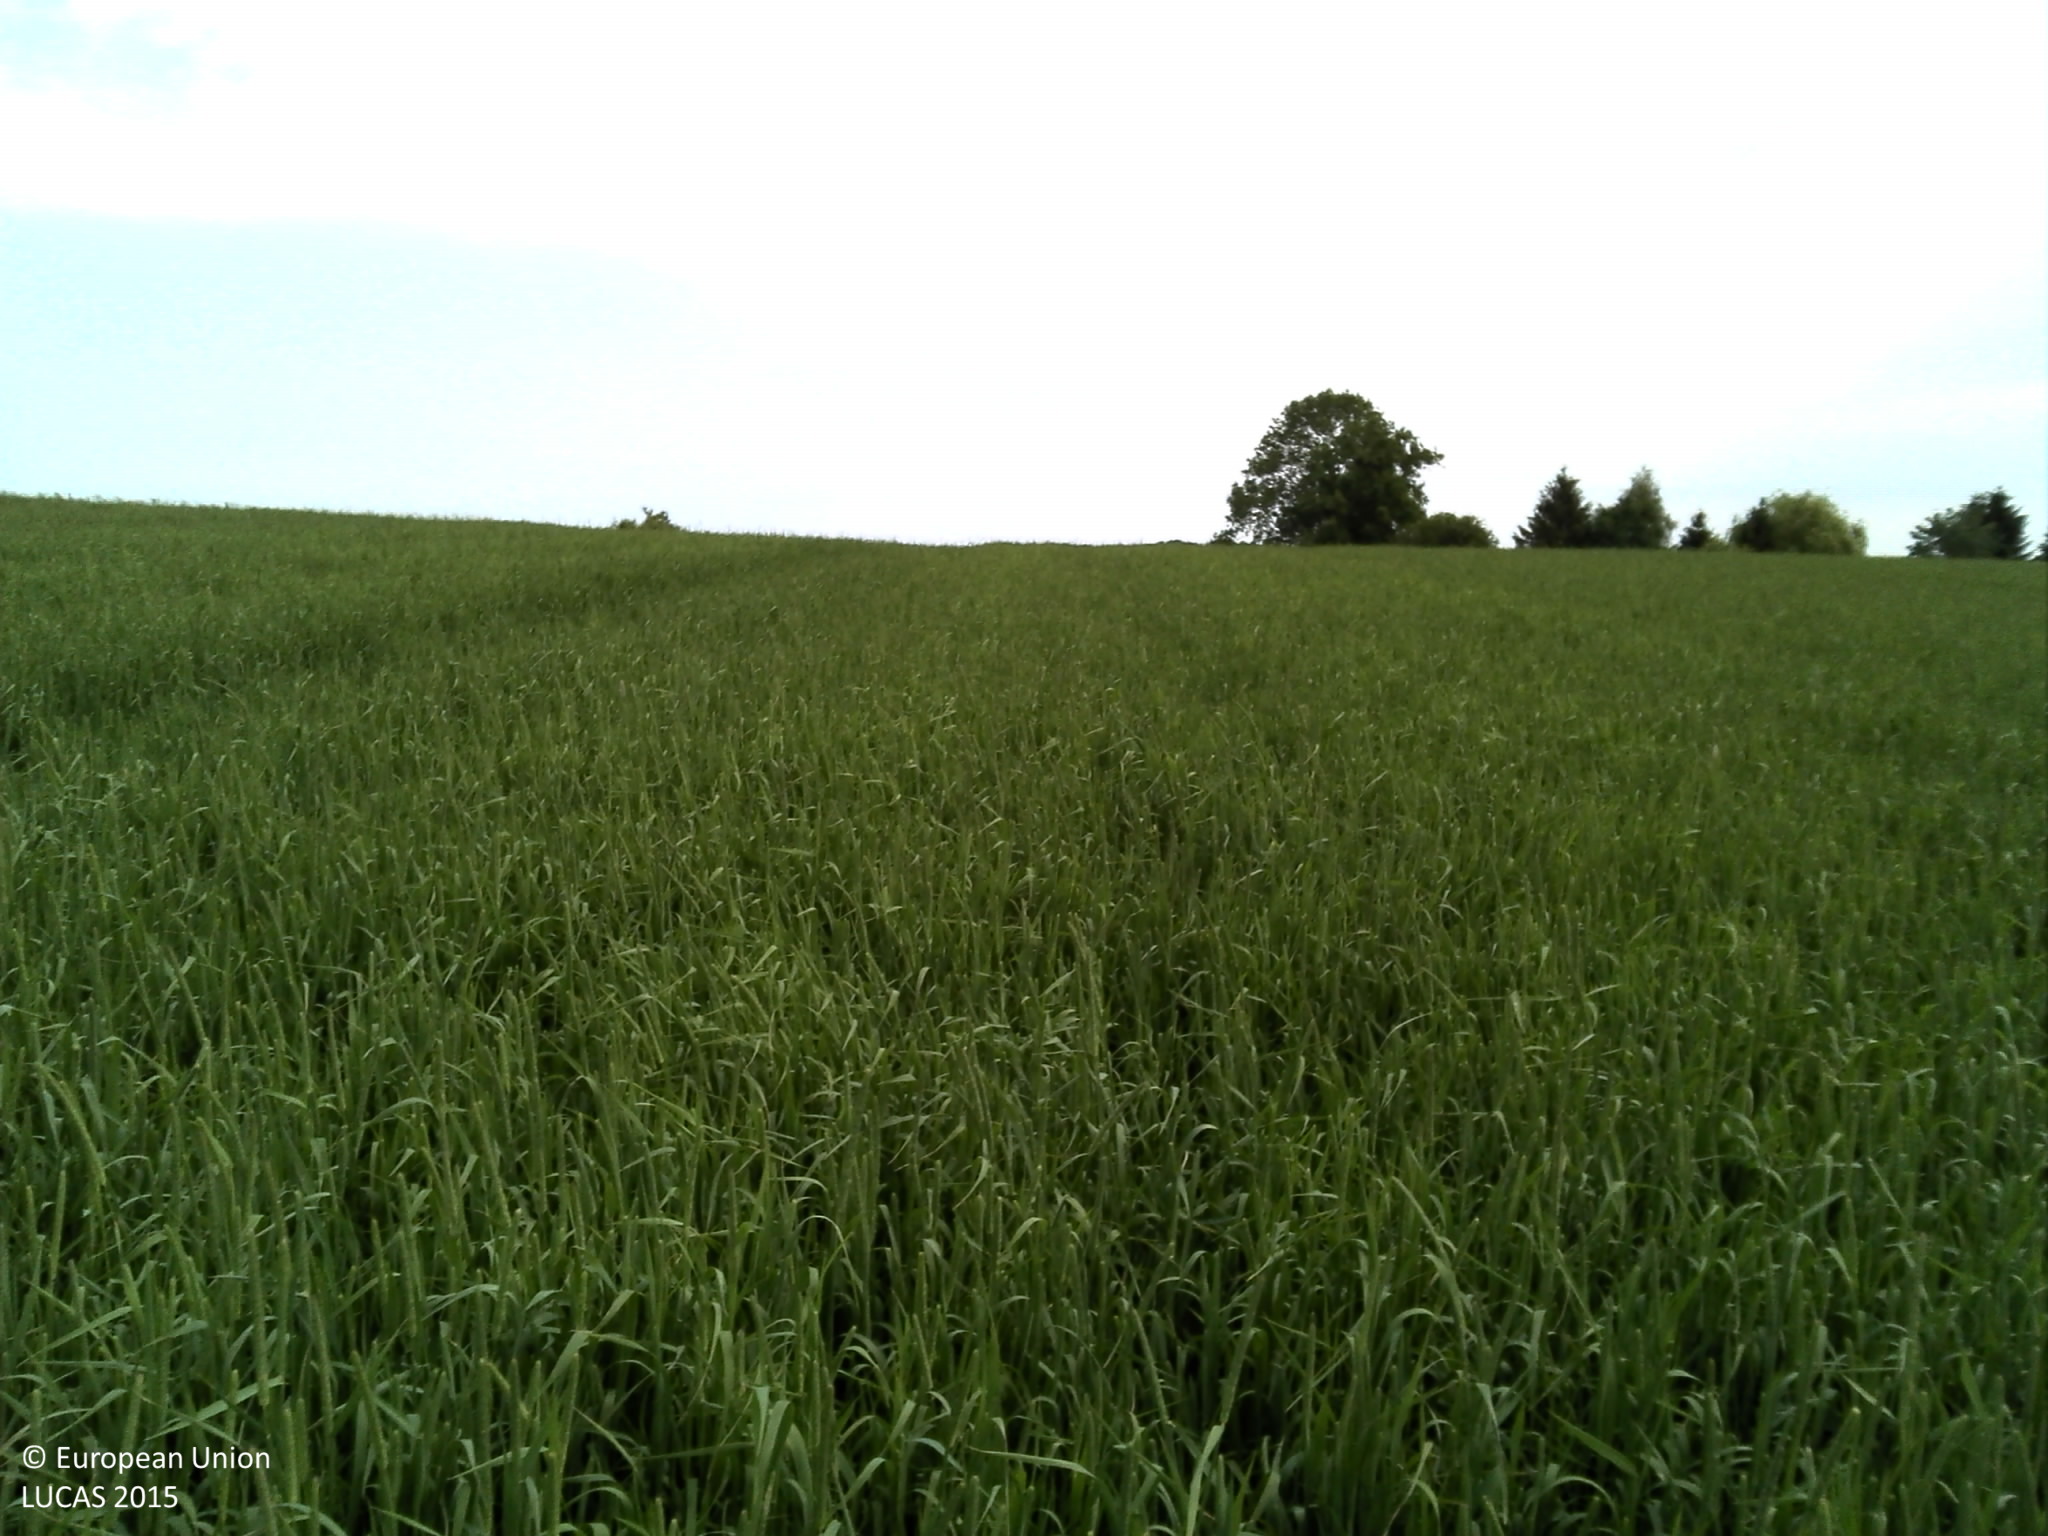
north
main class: Cropland
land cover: Temporary grasslands
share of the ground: > 75 %
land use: Agriculture (excluding fallow land and kitchen gardens)
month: June
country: LU
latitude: 49.5551
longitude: 5.9766
